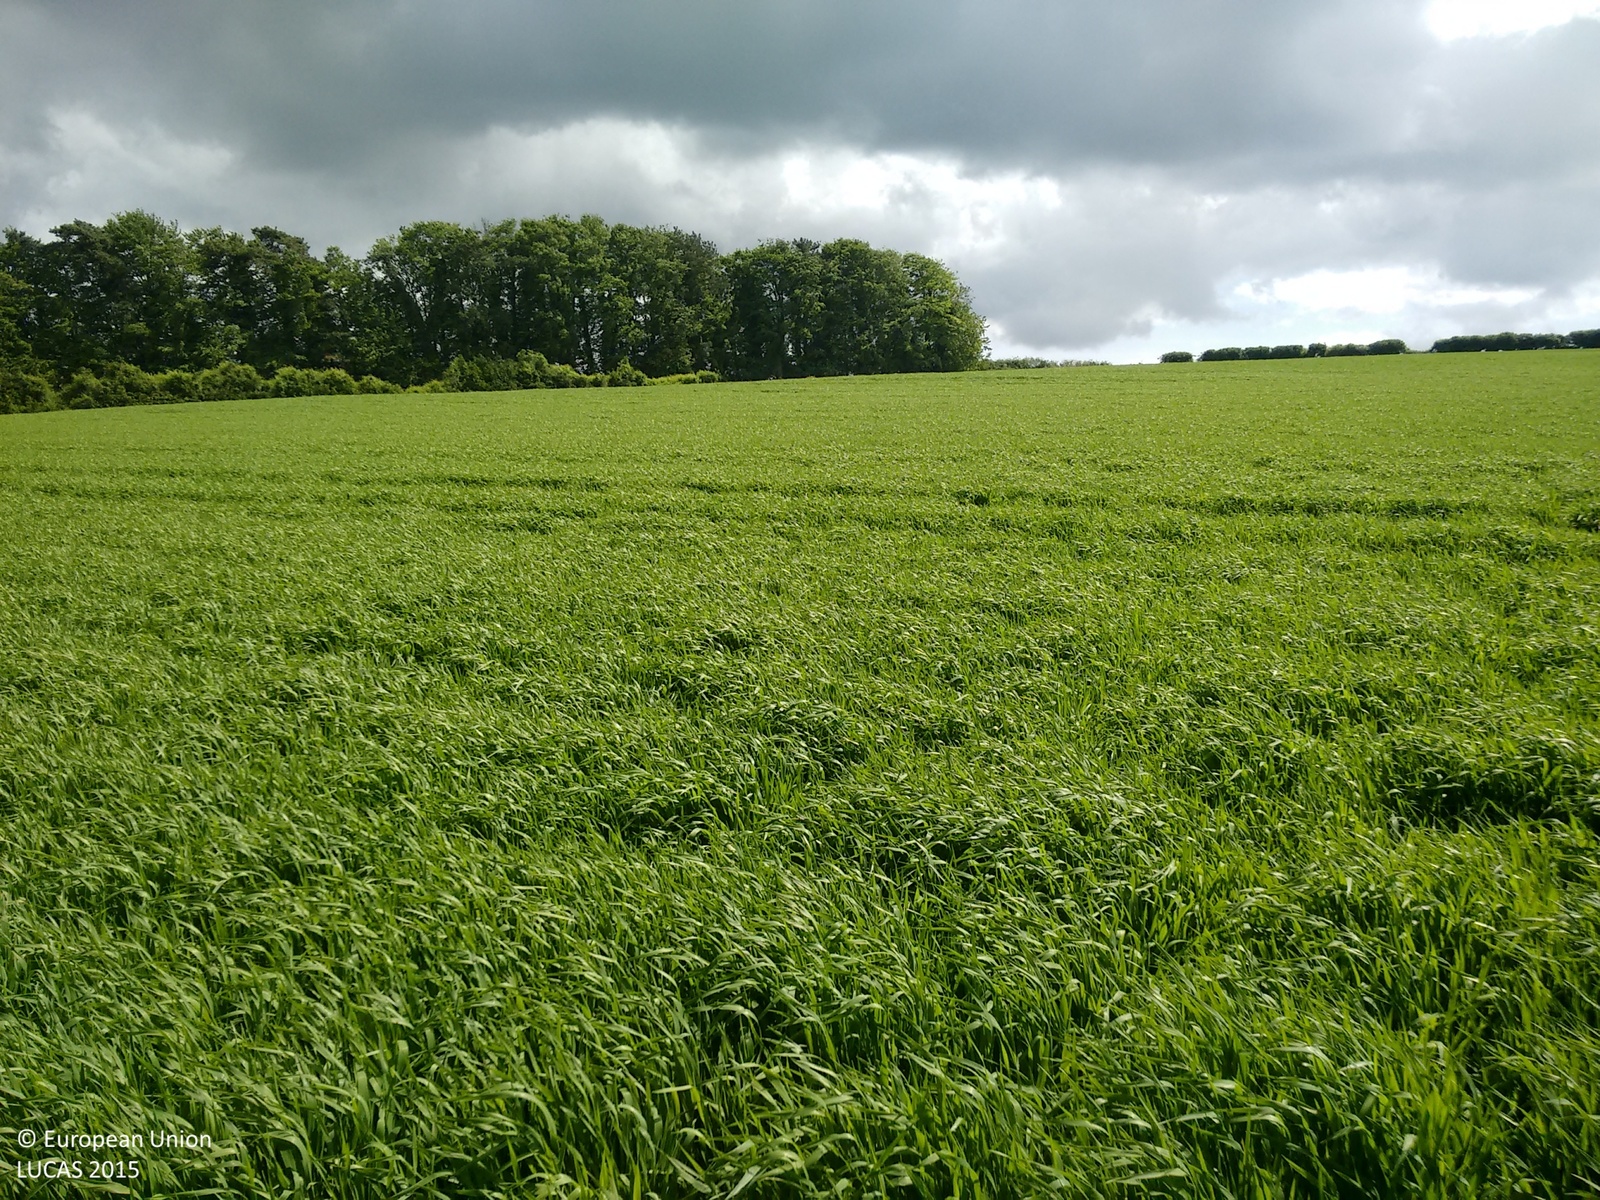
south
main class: Cropland
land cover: Barley
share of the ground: > 75 %
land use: Agriculture (excluding fallow land and kitchen gardens)
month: May
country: GB
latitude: 50.8209
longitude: -2.1692
